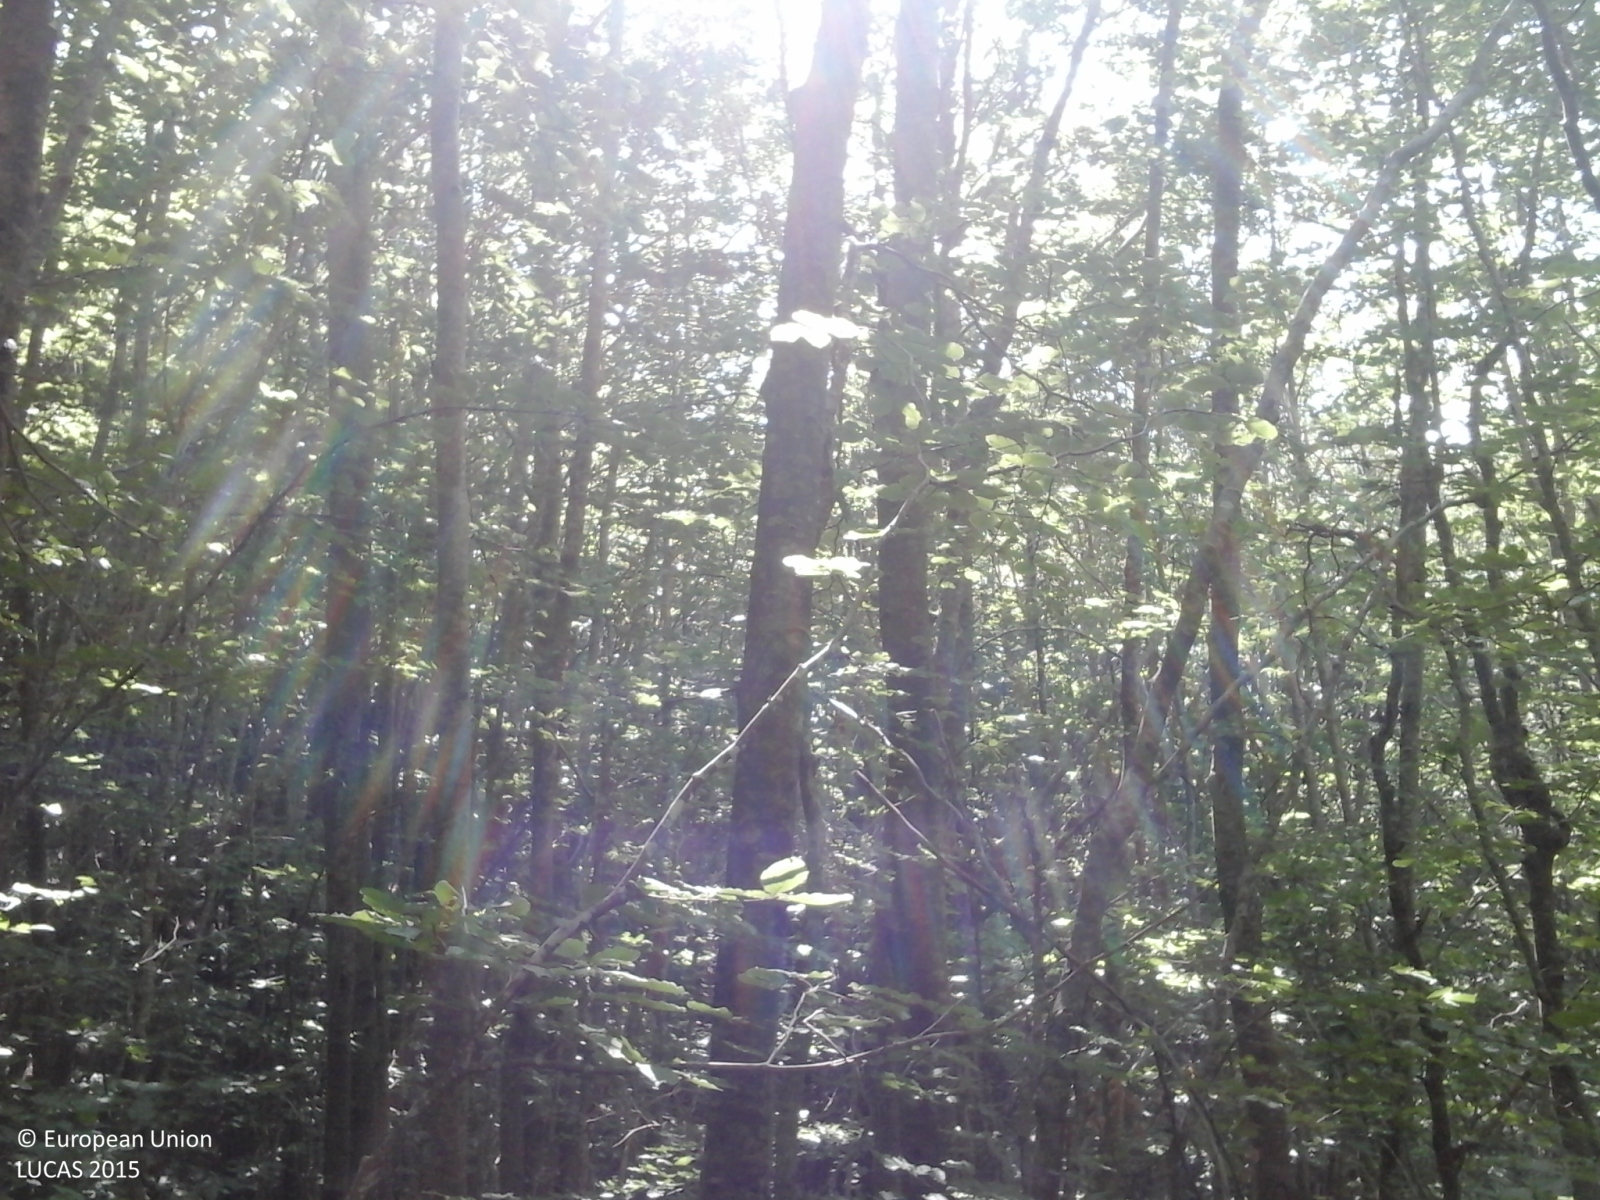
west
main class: Woodland
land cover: Broadleaved woodland
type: mountainous beech forest
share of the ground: > 75 %
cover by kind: broadleaved forest trees 100 %
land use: Forestry
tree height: > 5 m
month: July
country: IT
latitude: 44.1503
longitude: 10.6111
